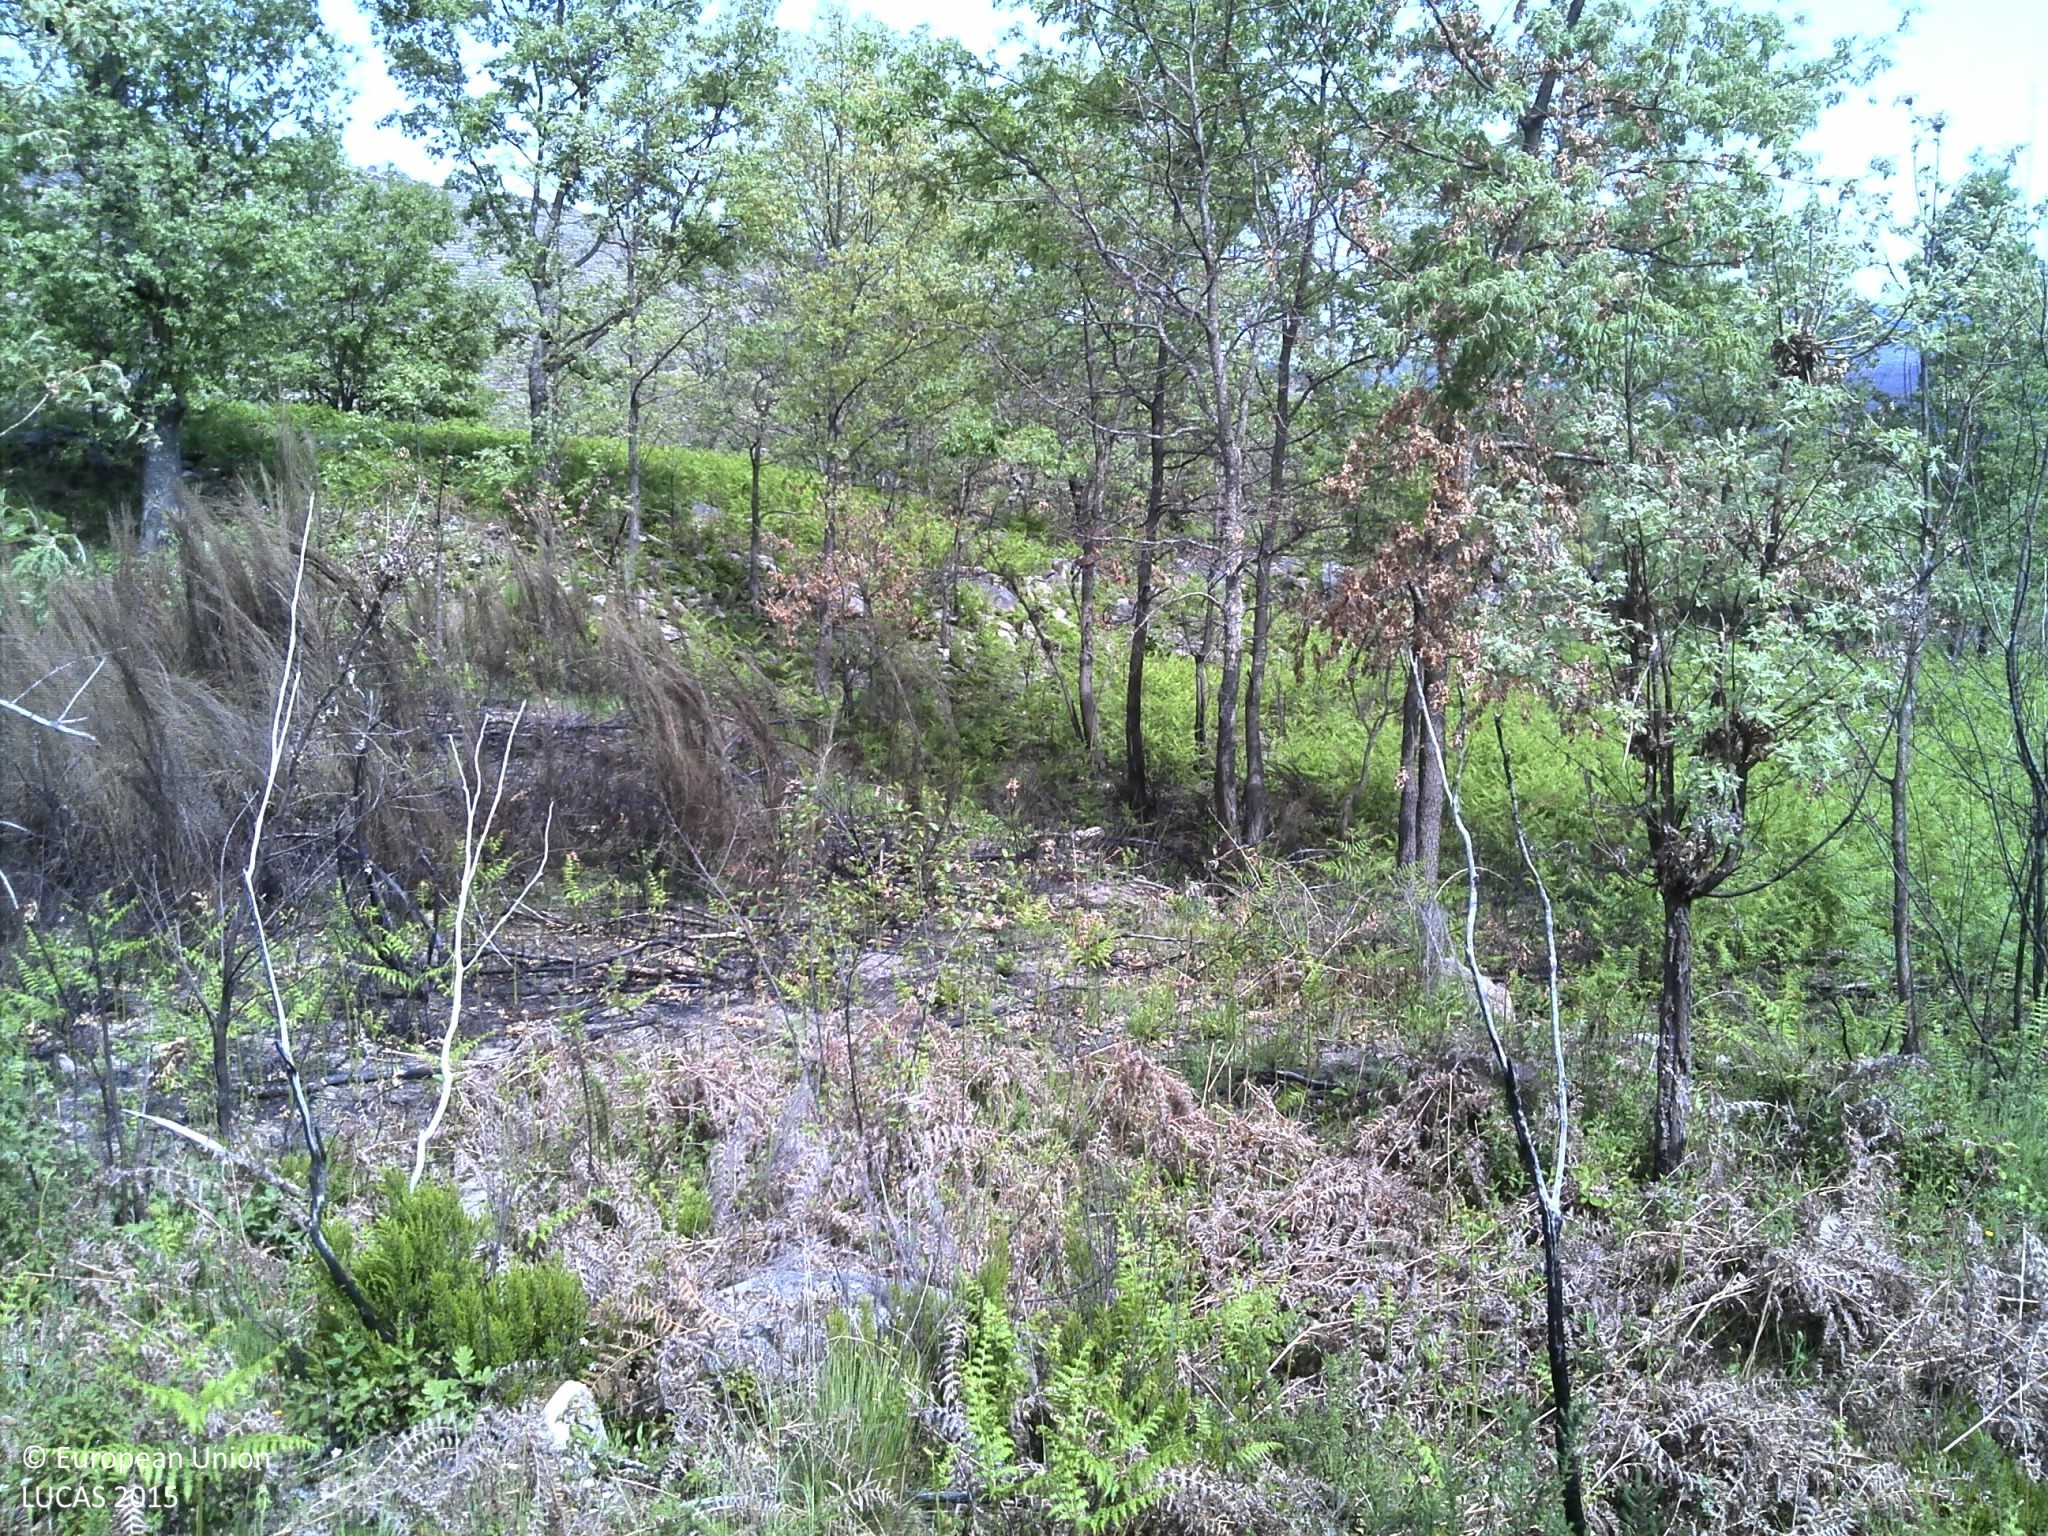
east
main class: Shrubland
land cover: Shrubland with sparse tree cover
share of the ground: 50 - 75 %
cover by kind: shrubs 70 %, unconsolidated bare surface 15 %, herbaceous plants 10 %, broadleaved forest trees 5 %
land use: Forestry
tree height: < 5 m
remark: Burnt area
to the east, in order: Shrubland with sparse tree cover; Broadleaved woodland; Fences; Ditches and canals; Shruby margins; Grassland without tree/shrub cover; Abandoned hedges; Rivers and streams; Abandoned hedges; Grassland without tree/shrub cover; Fences; Shrubland with sparse tree cover; Broadleaved woodland; Shrubland with sparse tree cover; Rock outcrops; Shrubland with sparse tree cover
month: May
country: PT
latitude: 41.9608
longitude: -7.0999
